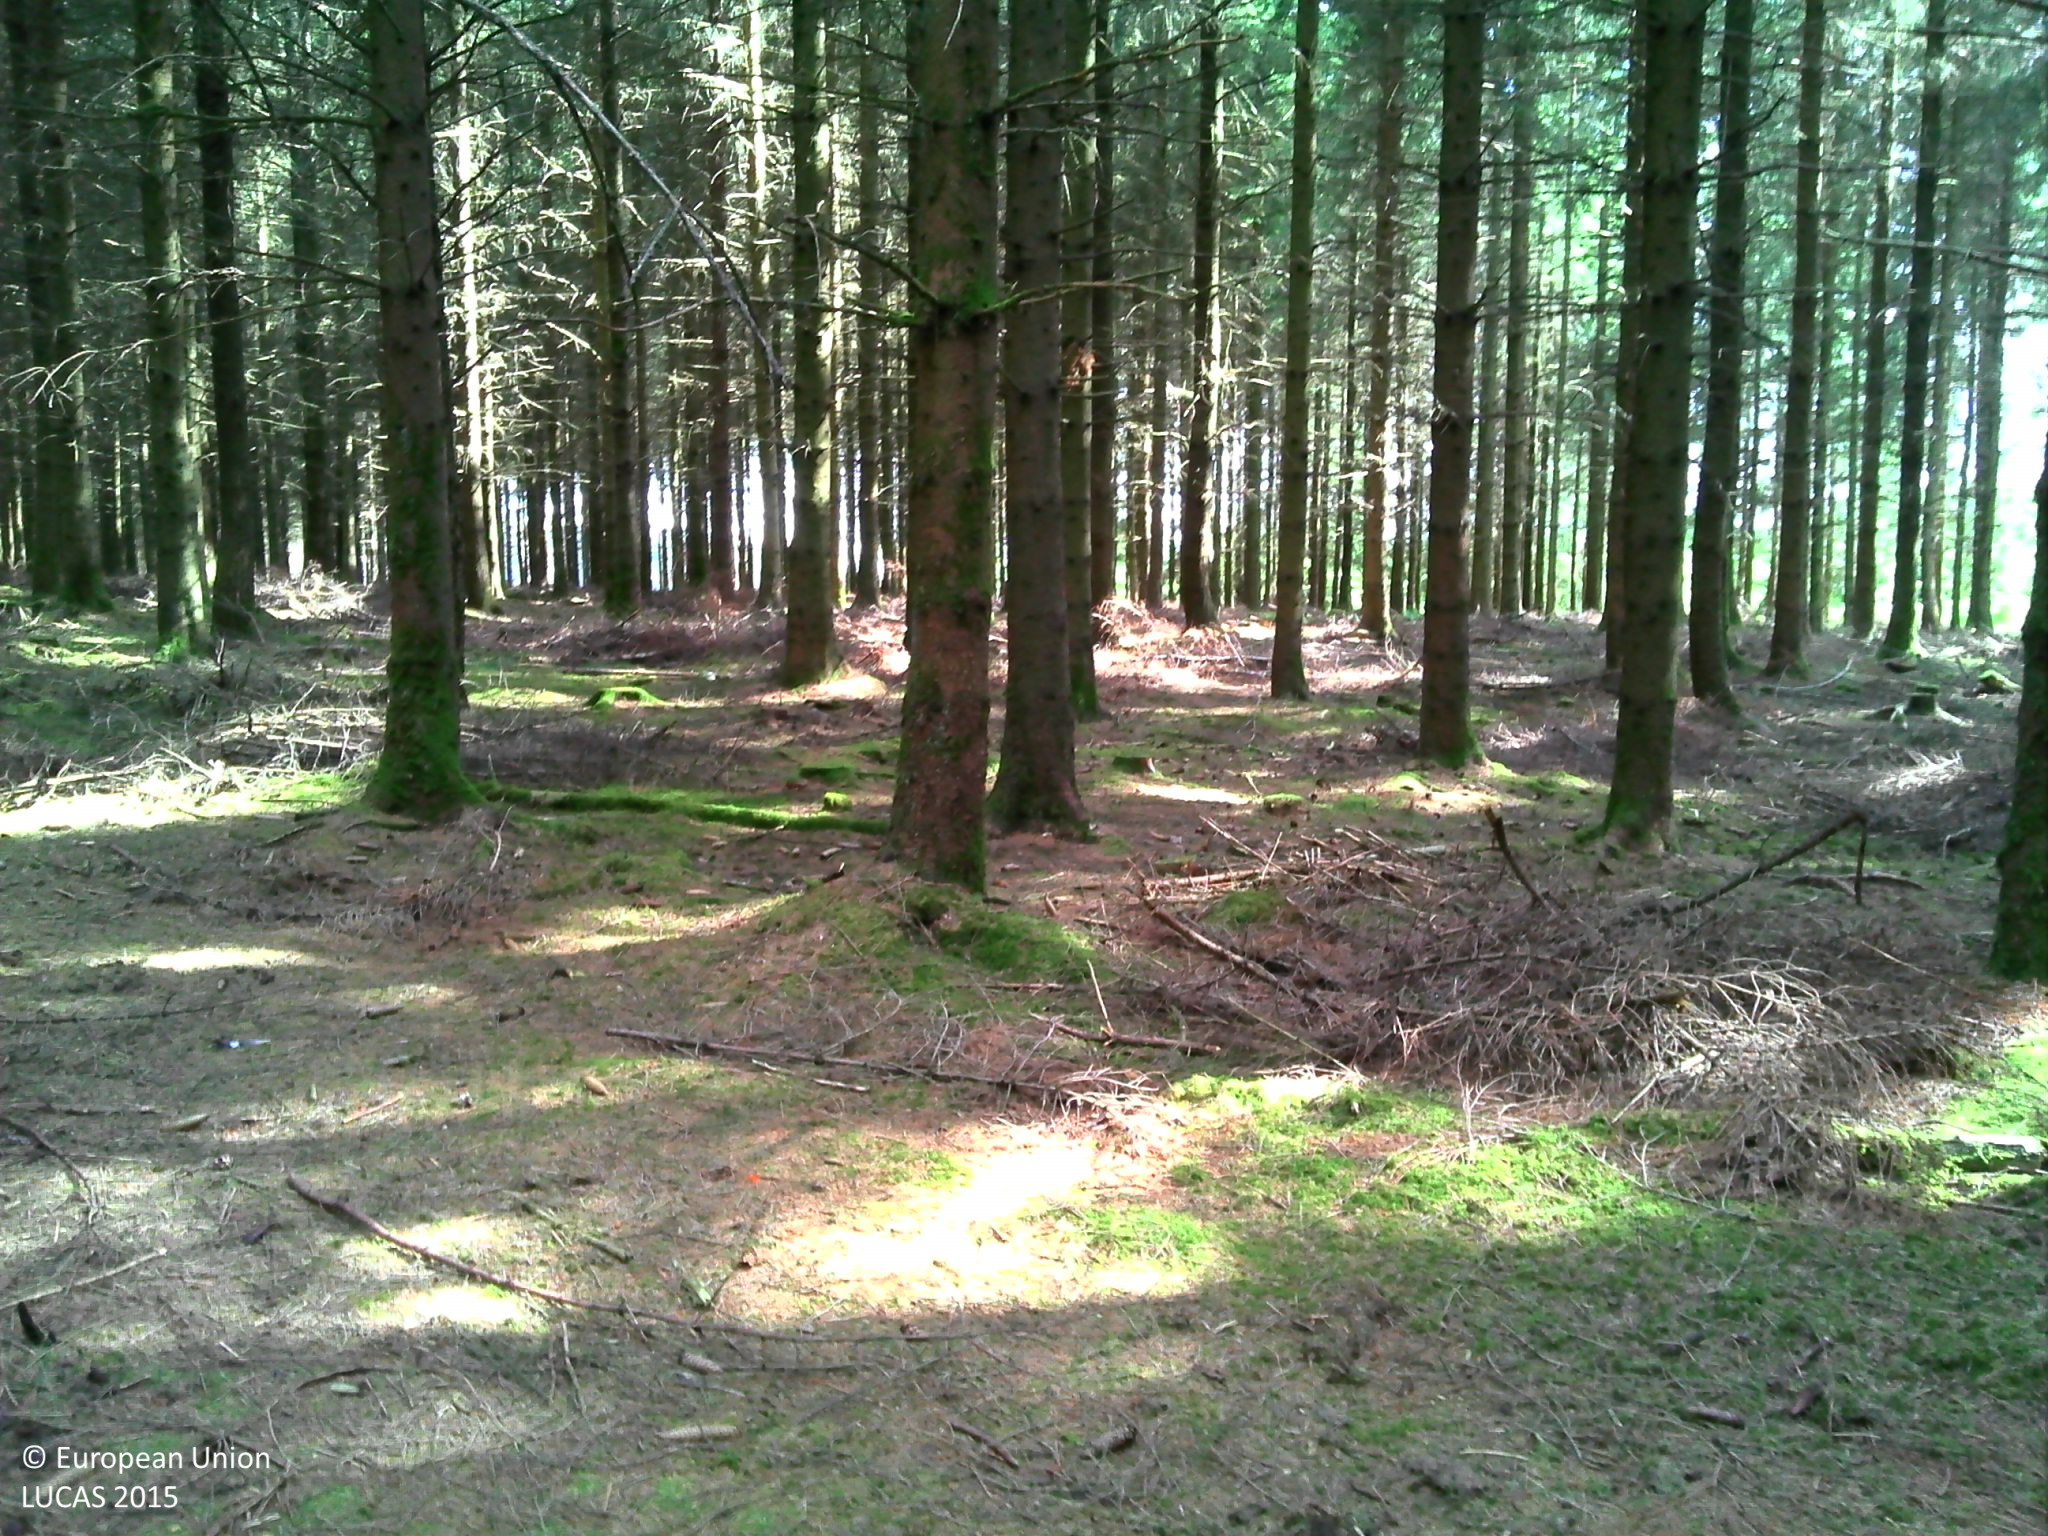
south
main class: Woodland
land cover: Spruce dominated coniferous woodland
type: hemiboreal forest and nemoral coniferous forest and mixed broadleaved-coniferous forest
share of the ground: > 75 %
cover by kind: coniferous forest trees 95 %, lichens and mosses 5 %
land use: Forestry
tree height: > 5 m
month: July
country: BE
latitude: 49.8447
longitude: 5.5346
